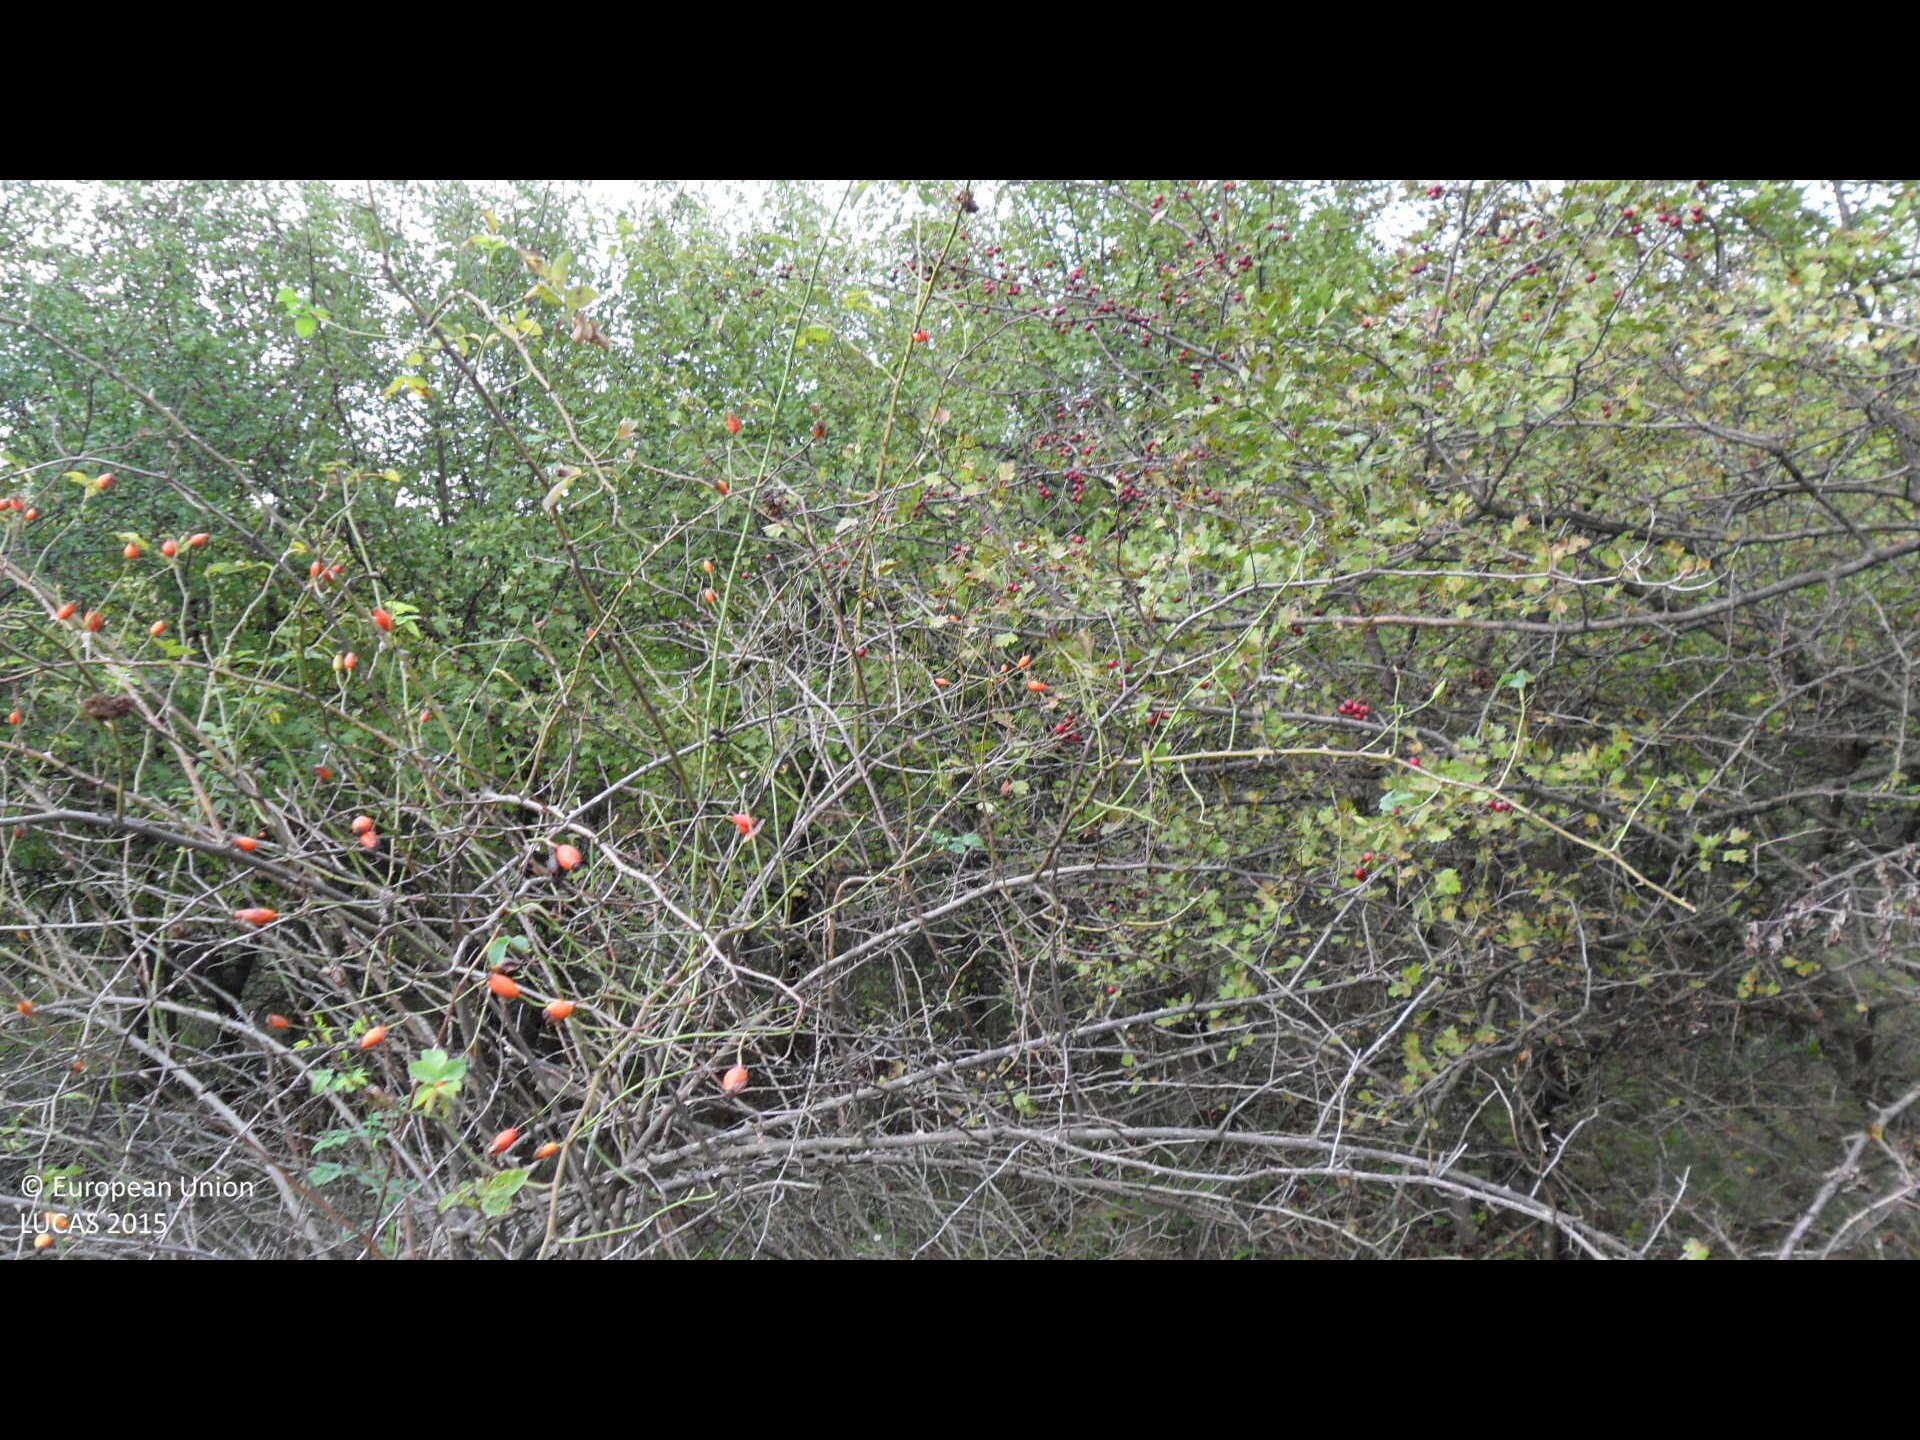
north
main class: Shrubland
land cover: Shrubland with sparse tree cover
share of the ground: > 75 %
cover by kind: shrubs 95 %, broadleaved forest trees 5 %
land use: Agriculture (excluding fallow land and kitchen gardens)
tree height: < 5 m
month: October
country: BG
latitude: 43.0824
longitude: 26.2207
